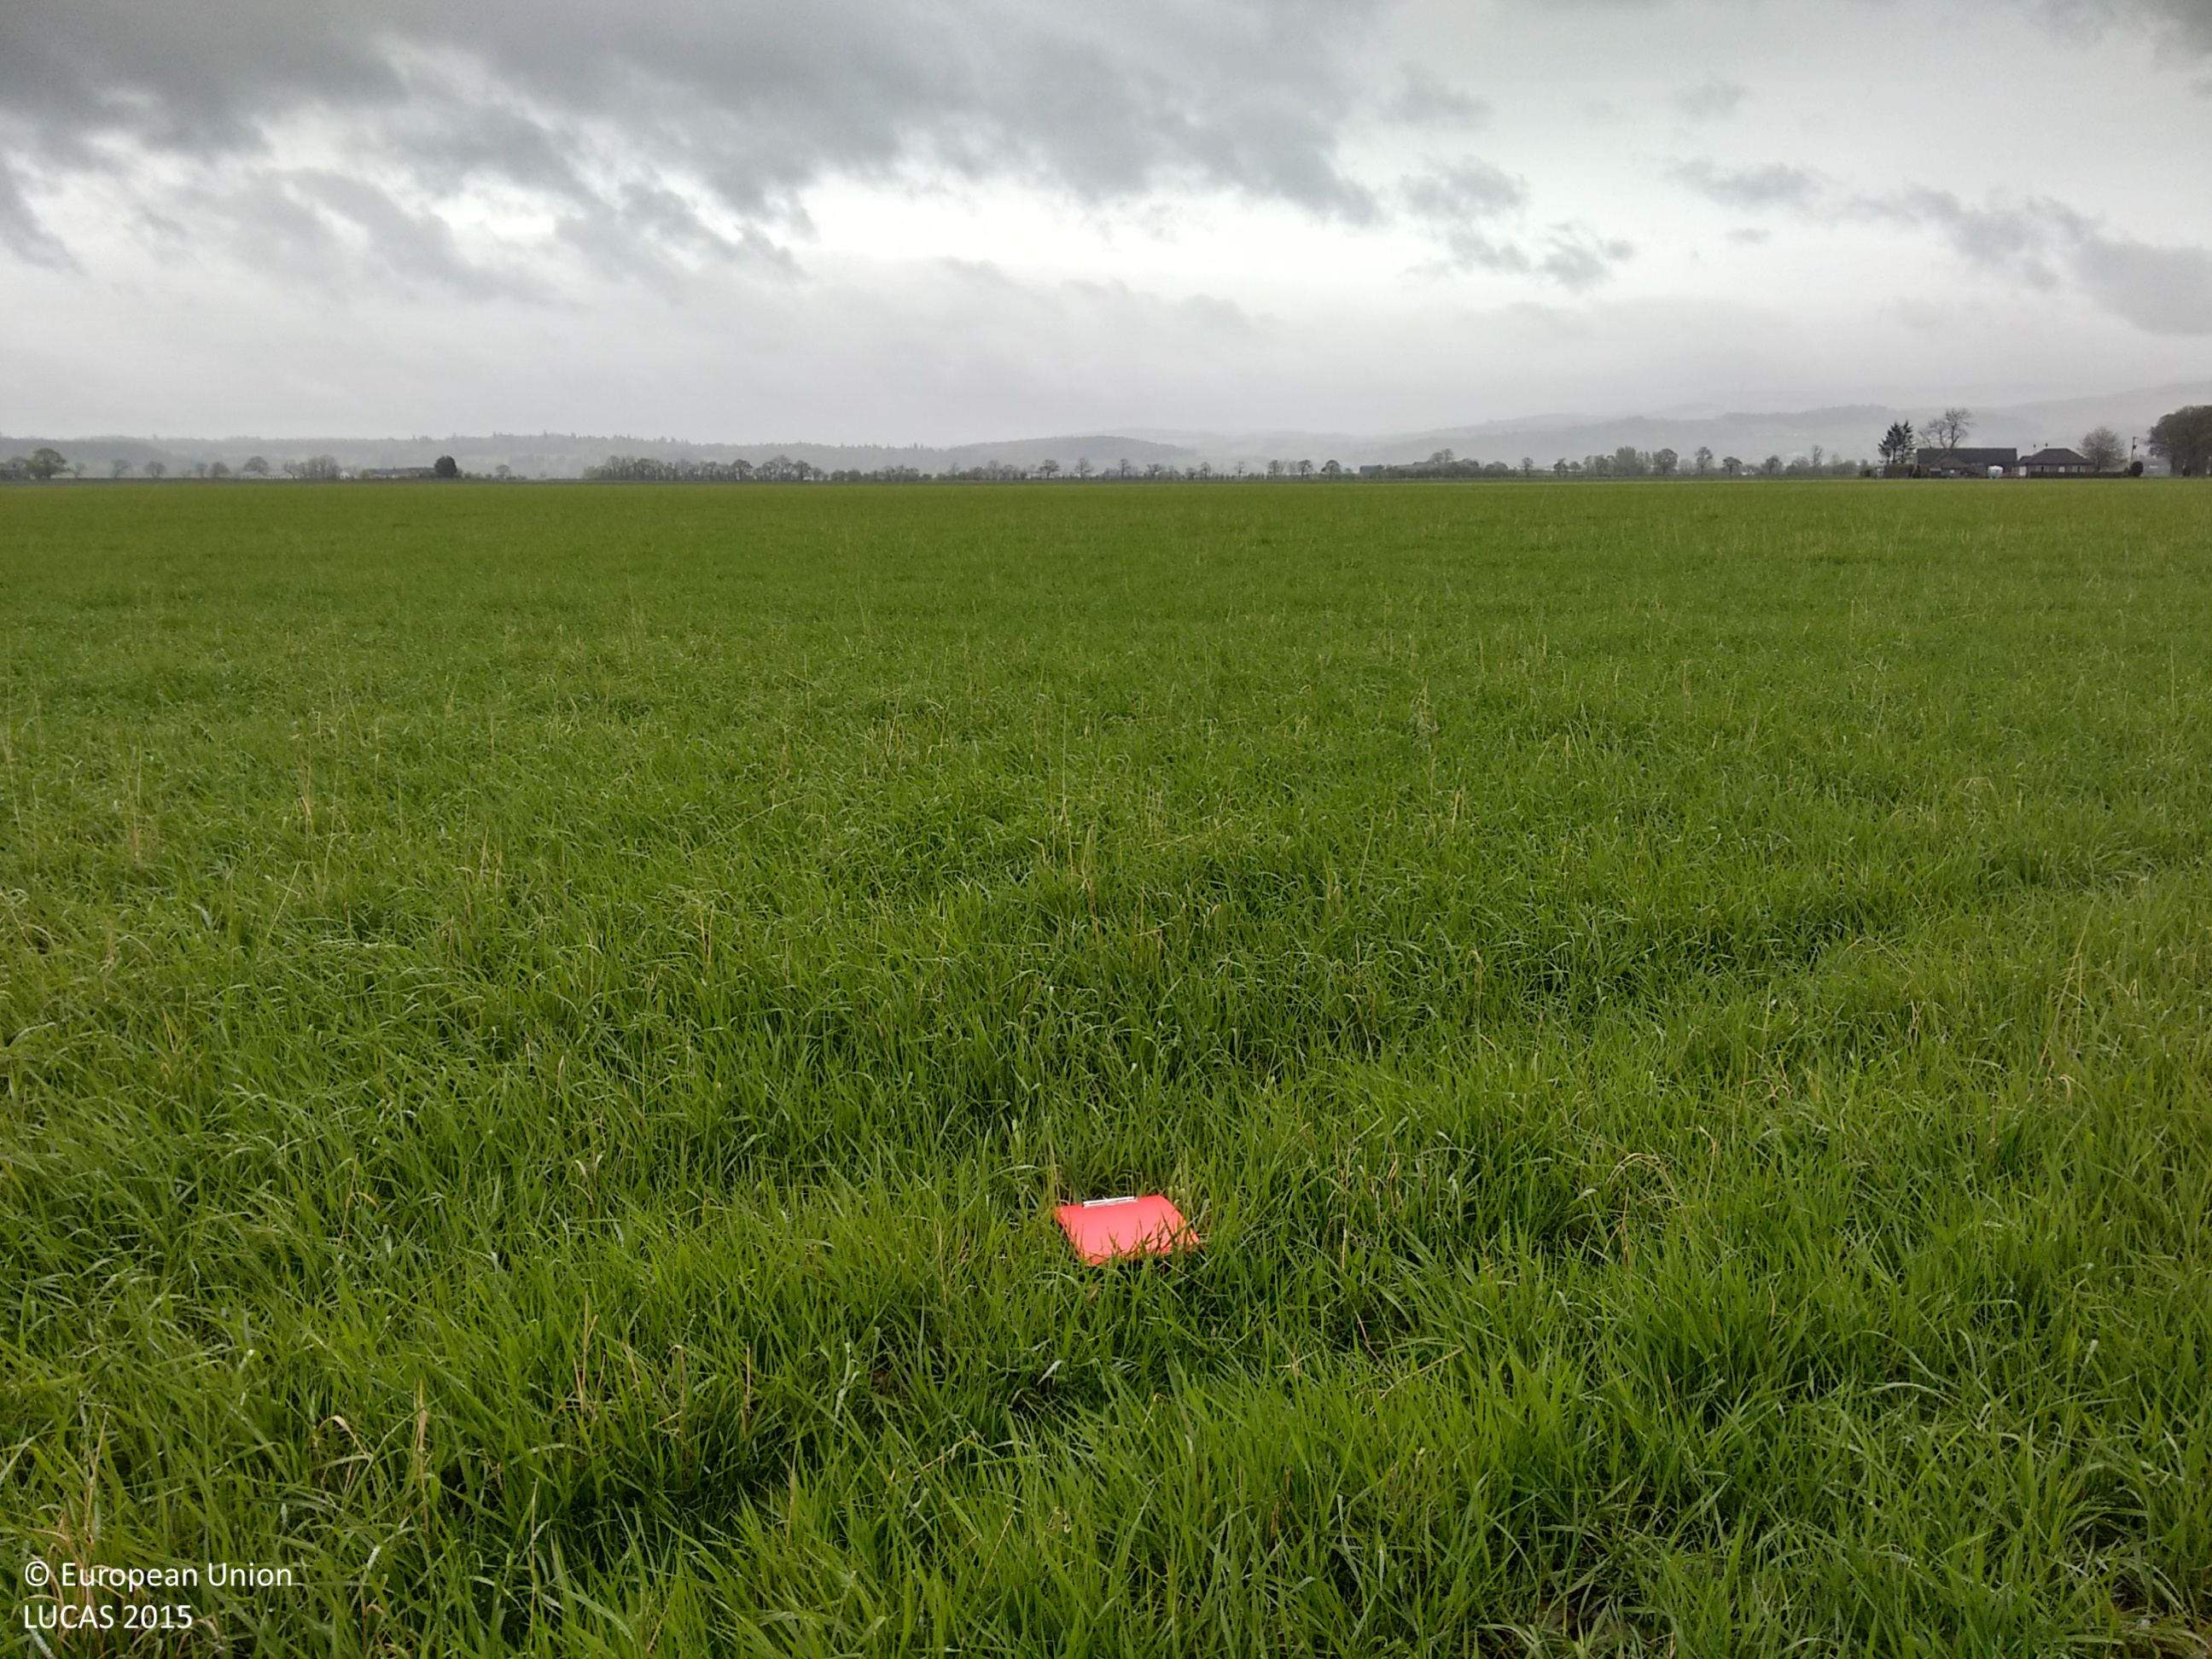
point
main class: Cropland
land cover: Mixed cereals for fodder
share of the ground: > 75 %
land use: Agriculture (excluding fallow land and kitchen gardens)
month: May
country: GB
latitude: 56.1277
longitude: -4.0028
